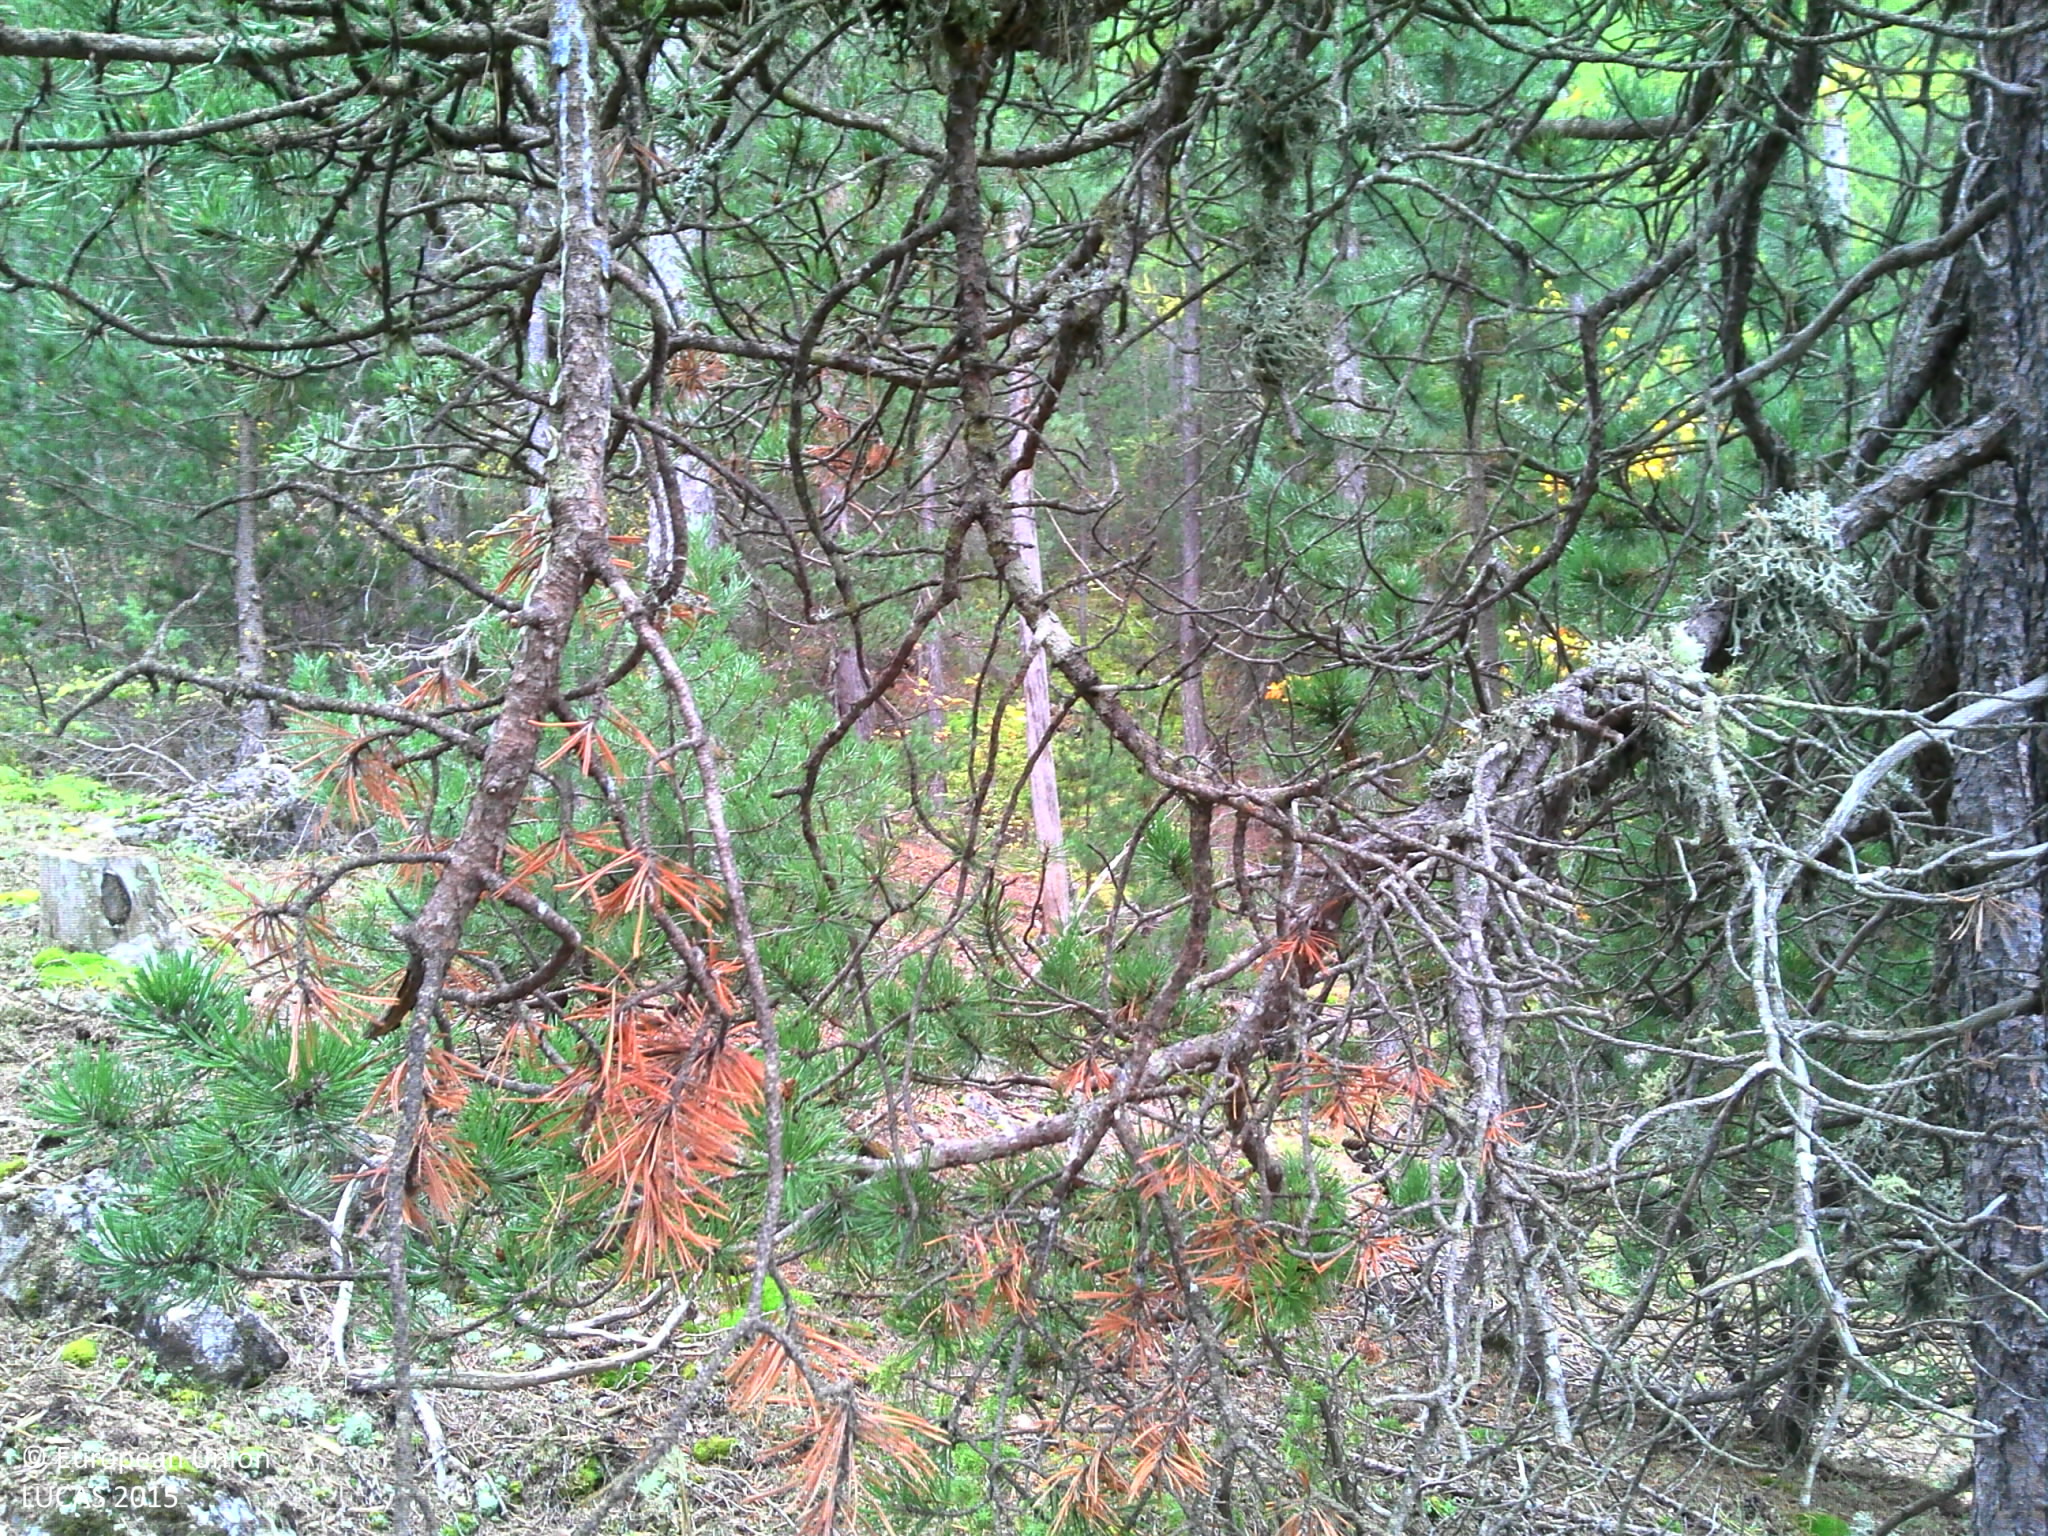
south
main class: Woodland
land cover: Pine dominated coniferous woodland
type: alpine coniferous forest
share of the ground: > 75 %
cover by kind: coniferous forest trees 70 %, unconsolidated bare surface 20 %, shrubs 5 %, lichens and mosses 5 %
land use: Forestry
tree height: > 5 m
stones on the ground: 10 - 25 %
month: October
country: FR
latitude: 44.8159
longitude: 6.5283
